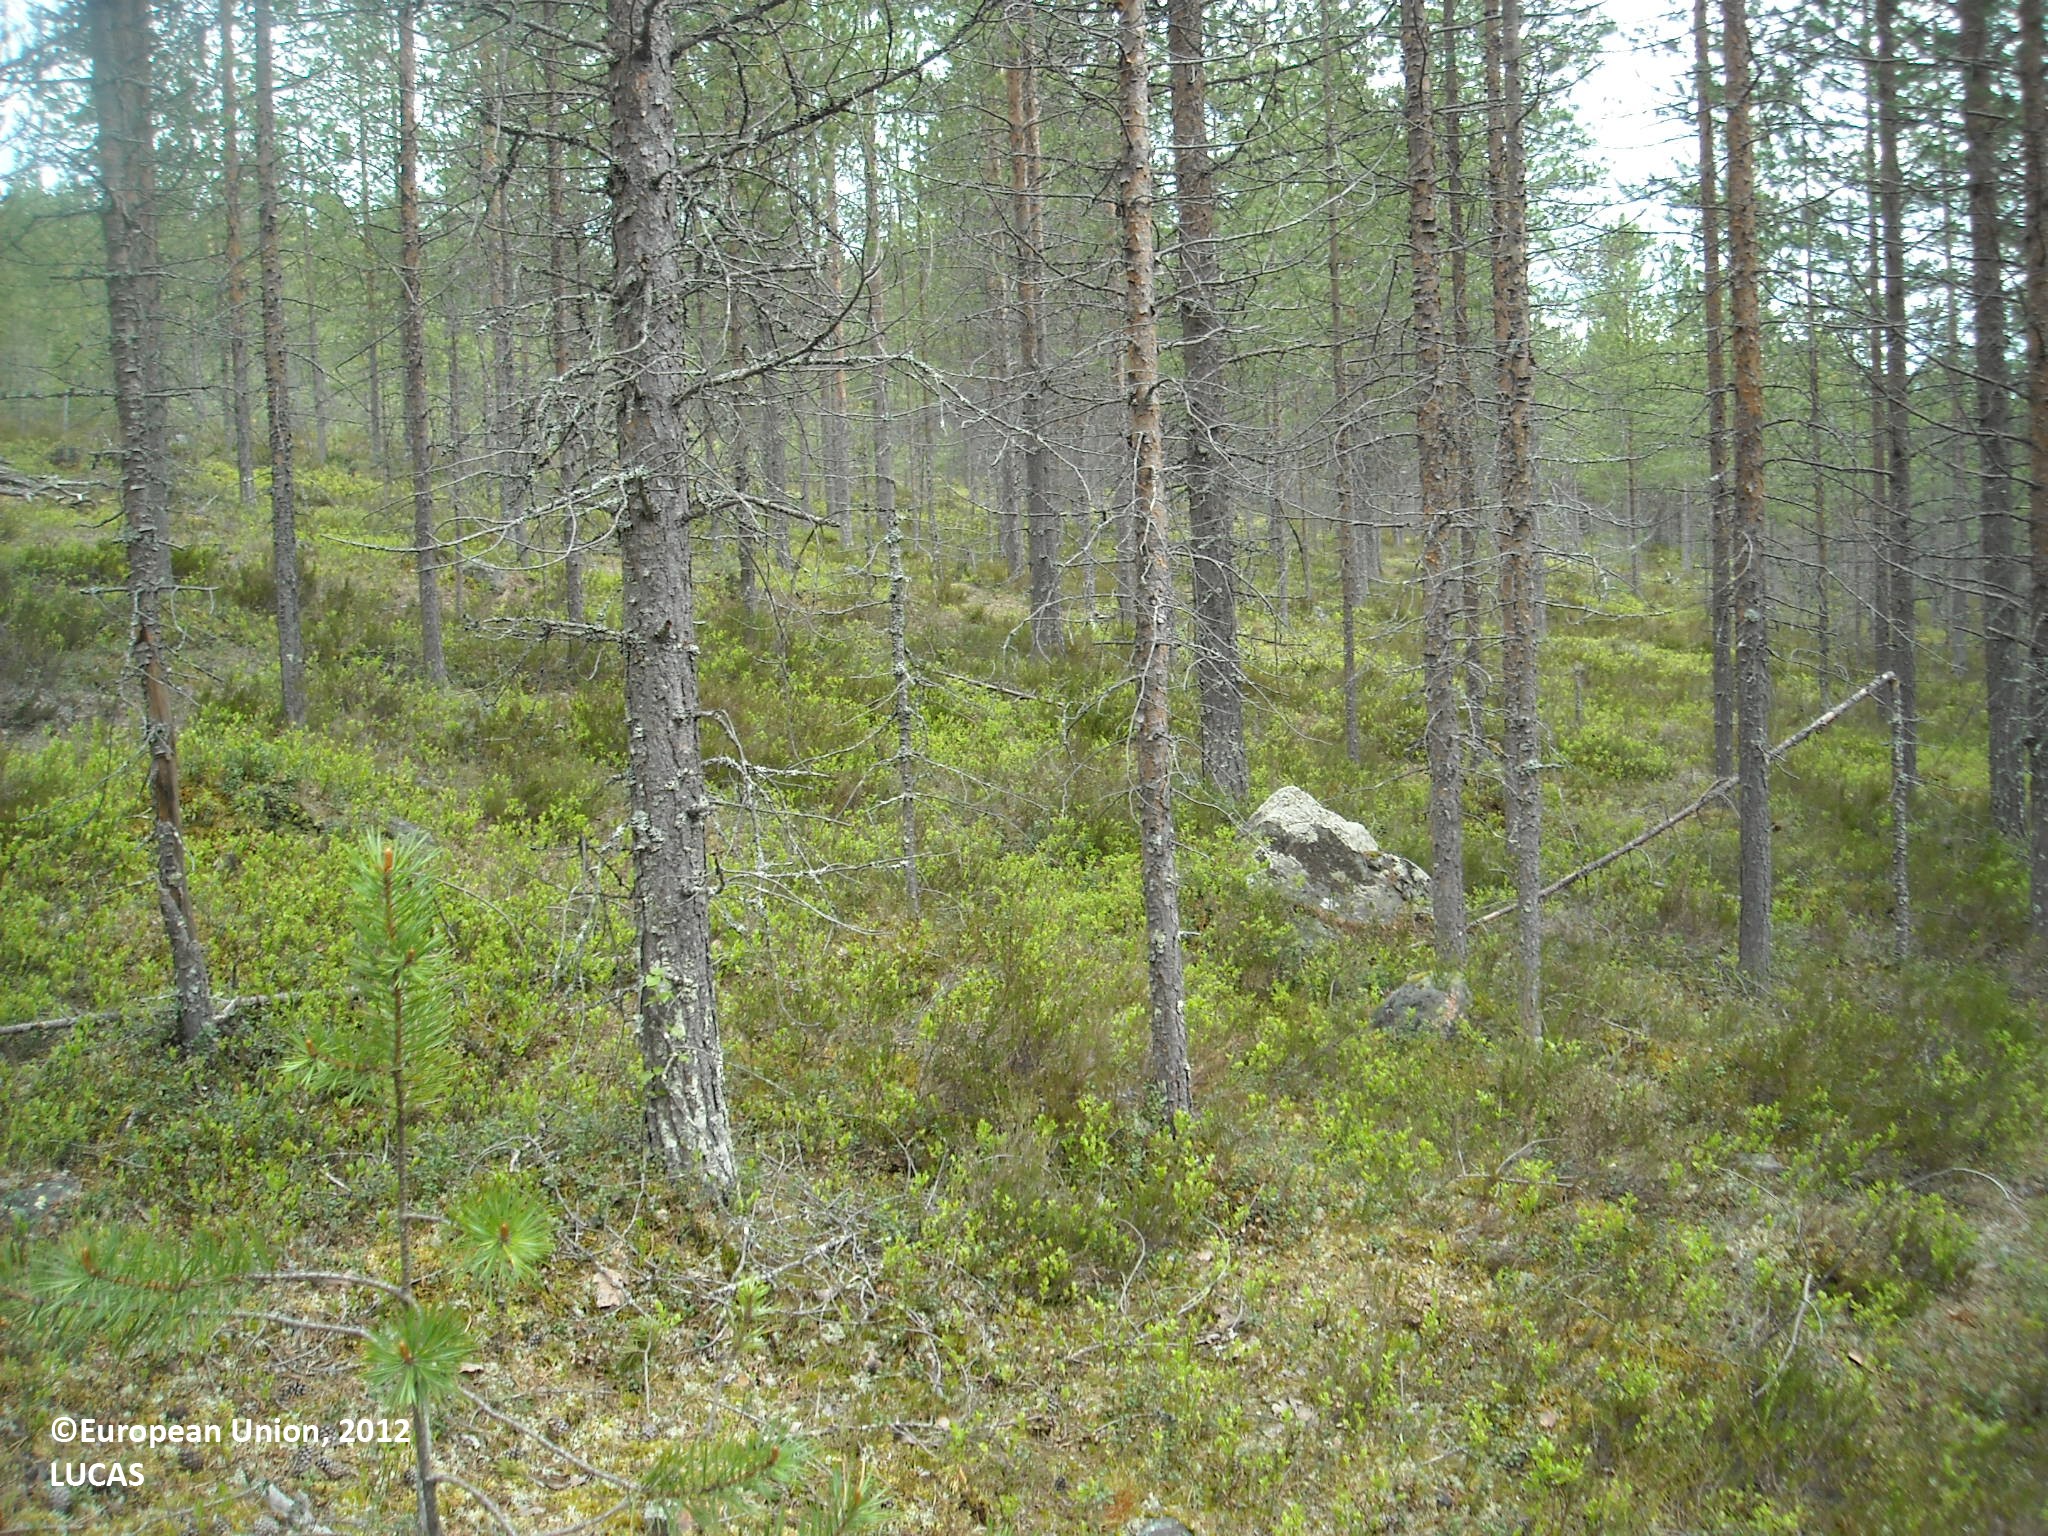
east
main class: Woodland
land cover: Pine dominated coniferous woodland
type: boreal forest
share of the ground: > 75 %
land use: Forestry
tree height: > 5 m
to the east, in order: Pine dominated coniferous woodland
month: June
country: FI
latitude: 65.2343
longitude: 27.7039
